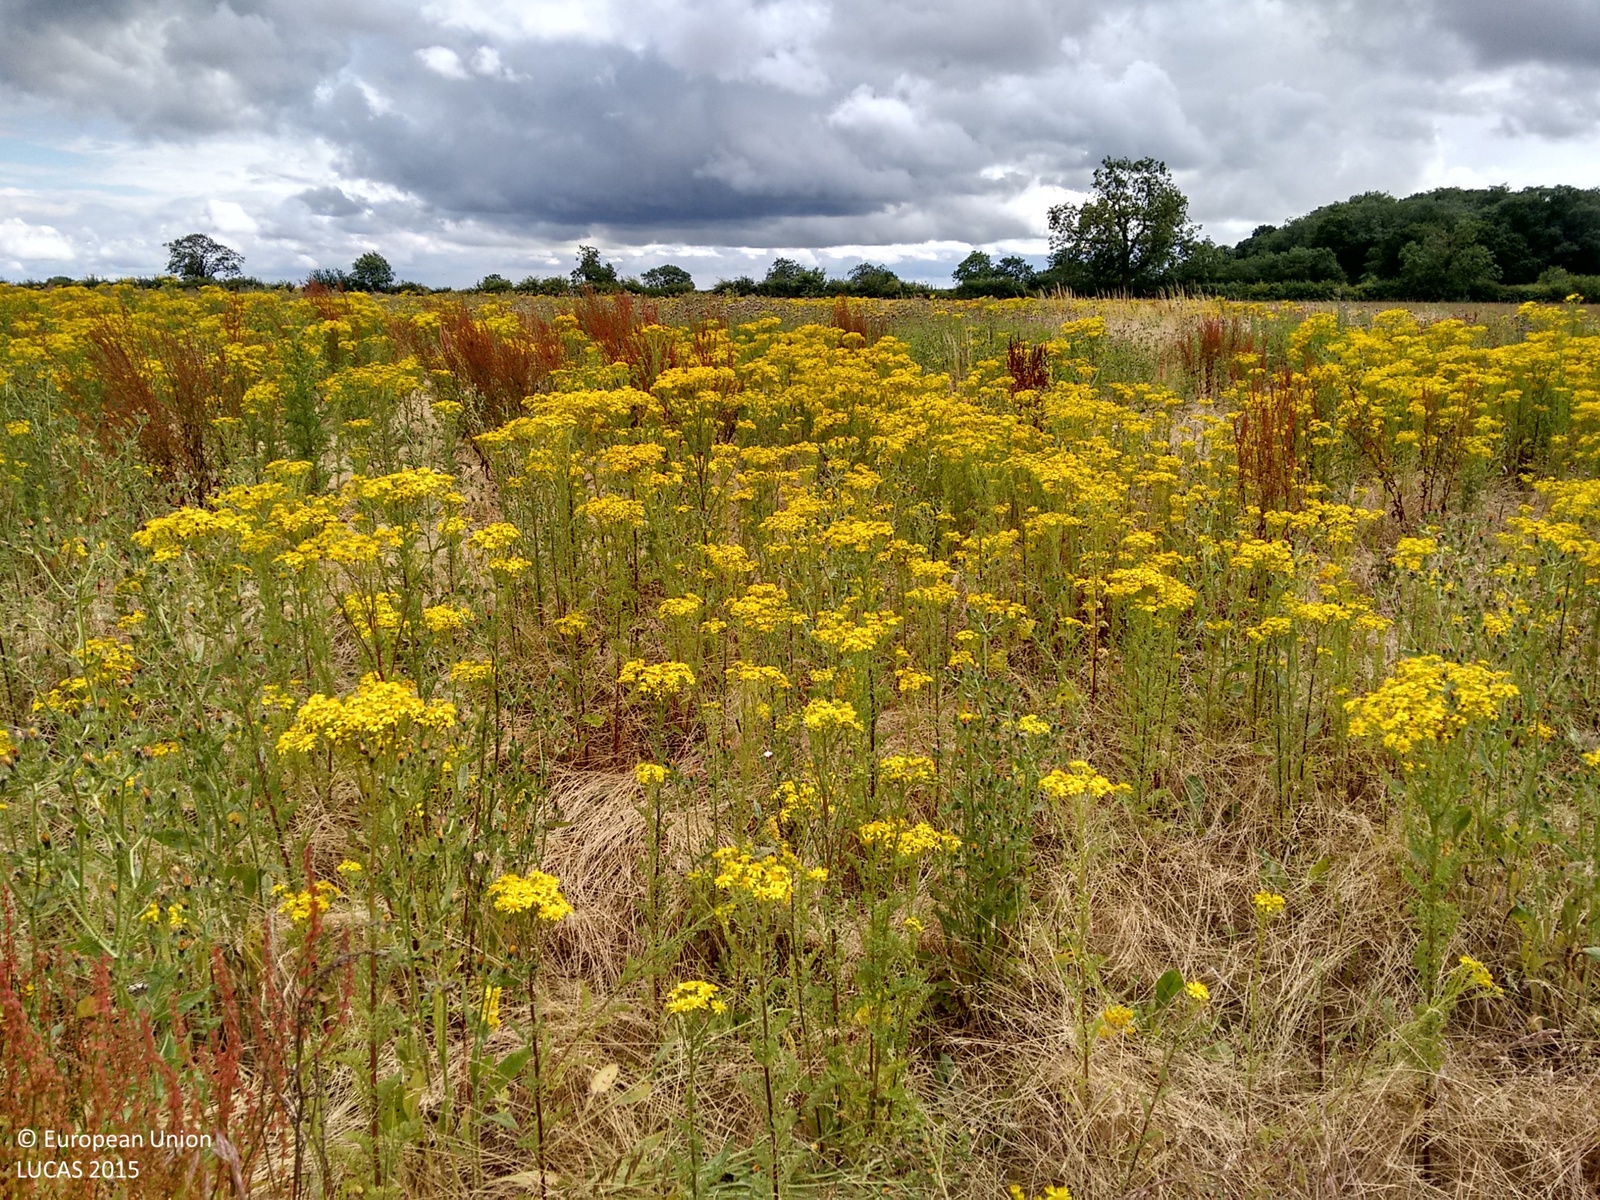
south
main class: Grassland
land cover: Spontaneously vegetated surfaces
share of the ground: > 75 %
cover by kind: herbaceous plants 100 %
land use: Fallow land
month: July
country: GB
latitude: 52.7884
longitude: -0.8218
